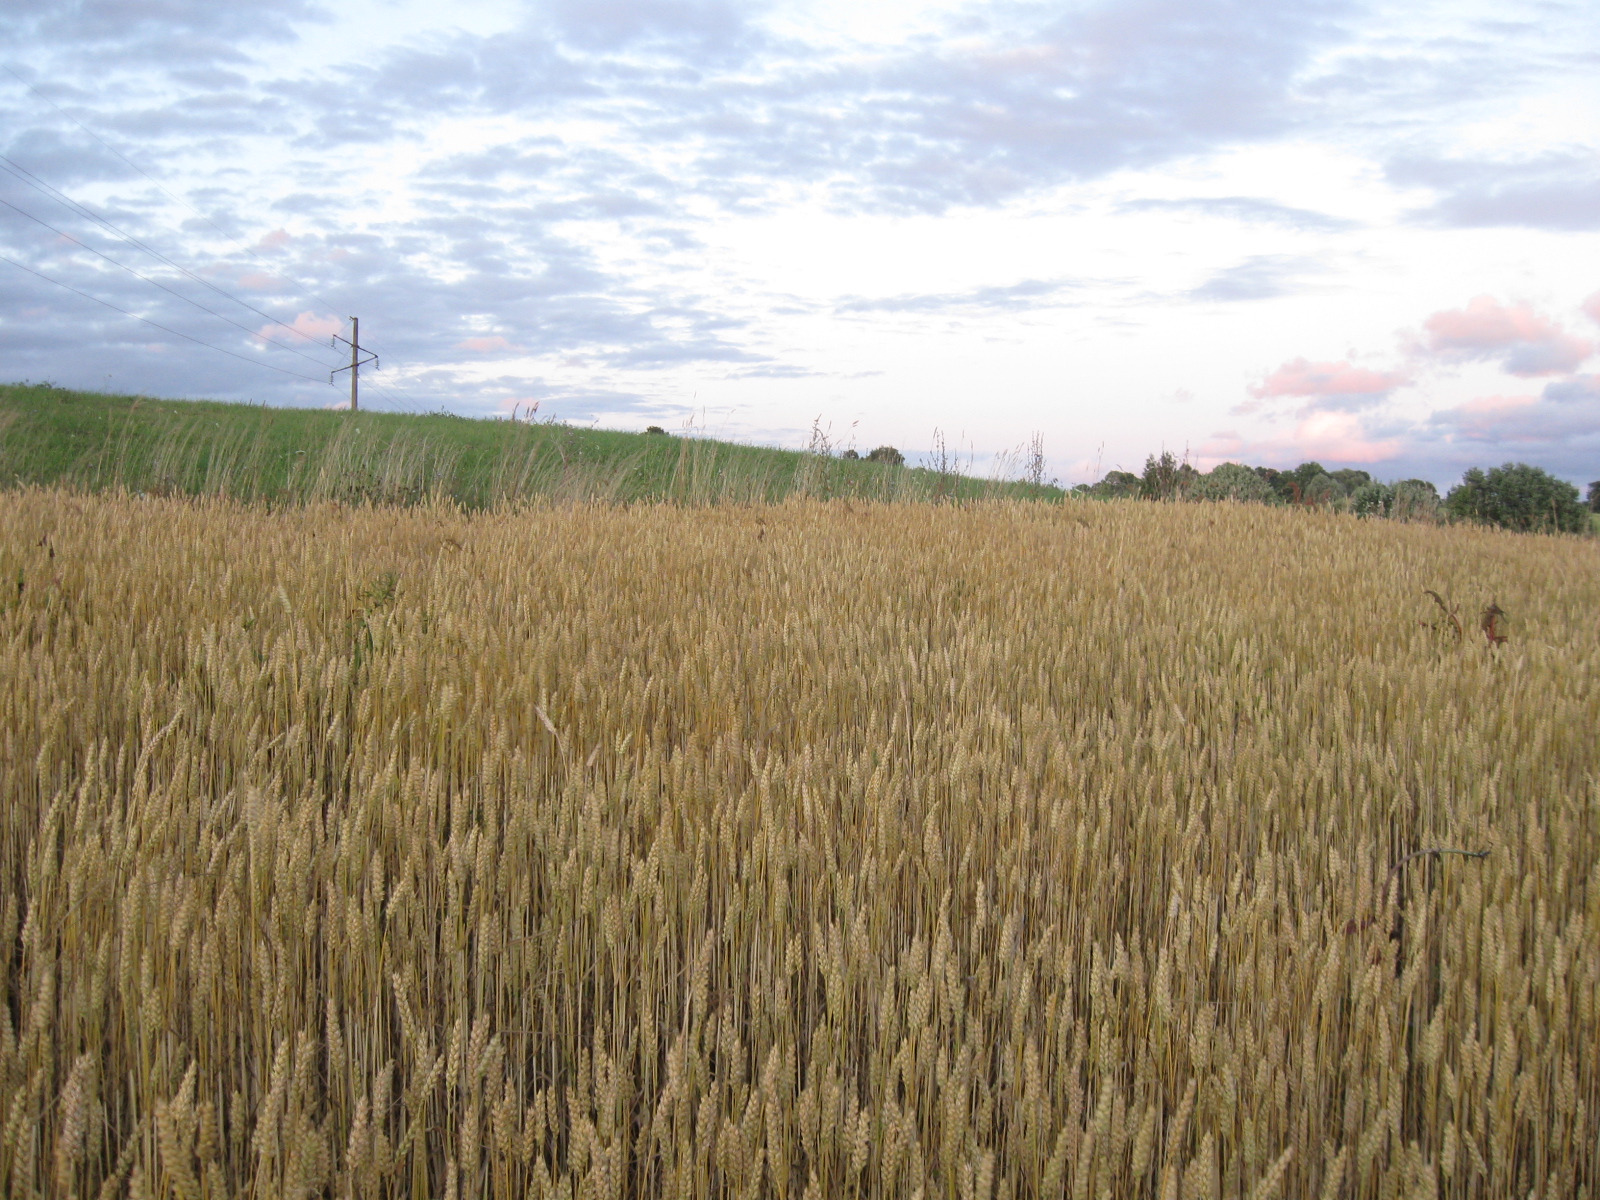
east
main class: Cropland
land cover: Common wheat
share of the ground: > 75 %
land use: Agriculture (excluding fallow land and kitchen gardens)
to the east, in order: Common wheat; Grassland without tree/shrub cover; Common wheat; Grassland without tree/shrub cover; Tracks; Grassland without tree/shrub cover; Other fruit trees and berries
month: July
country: LT
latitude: 54.3707
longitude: 24.3380
